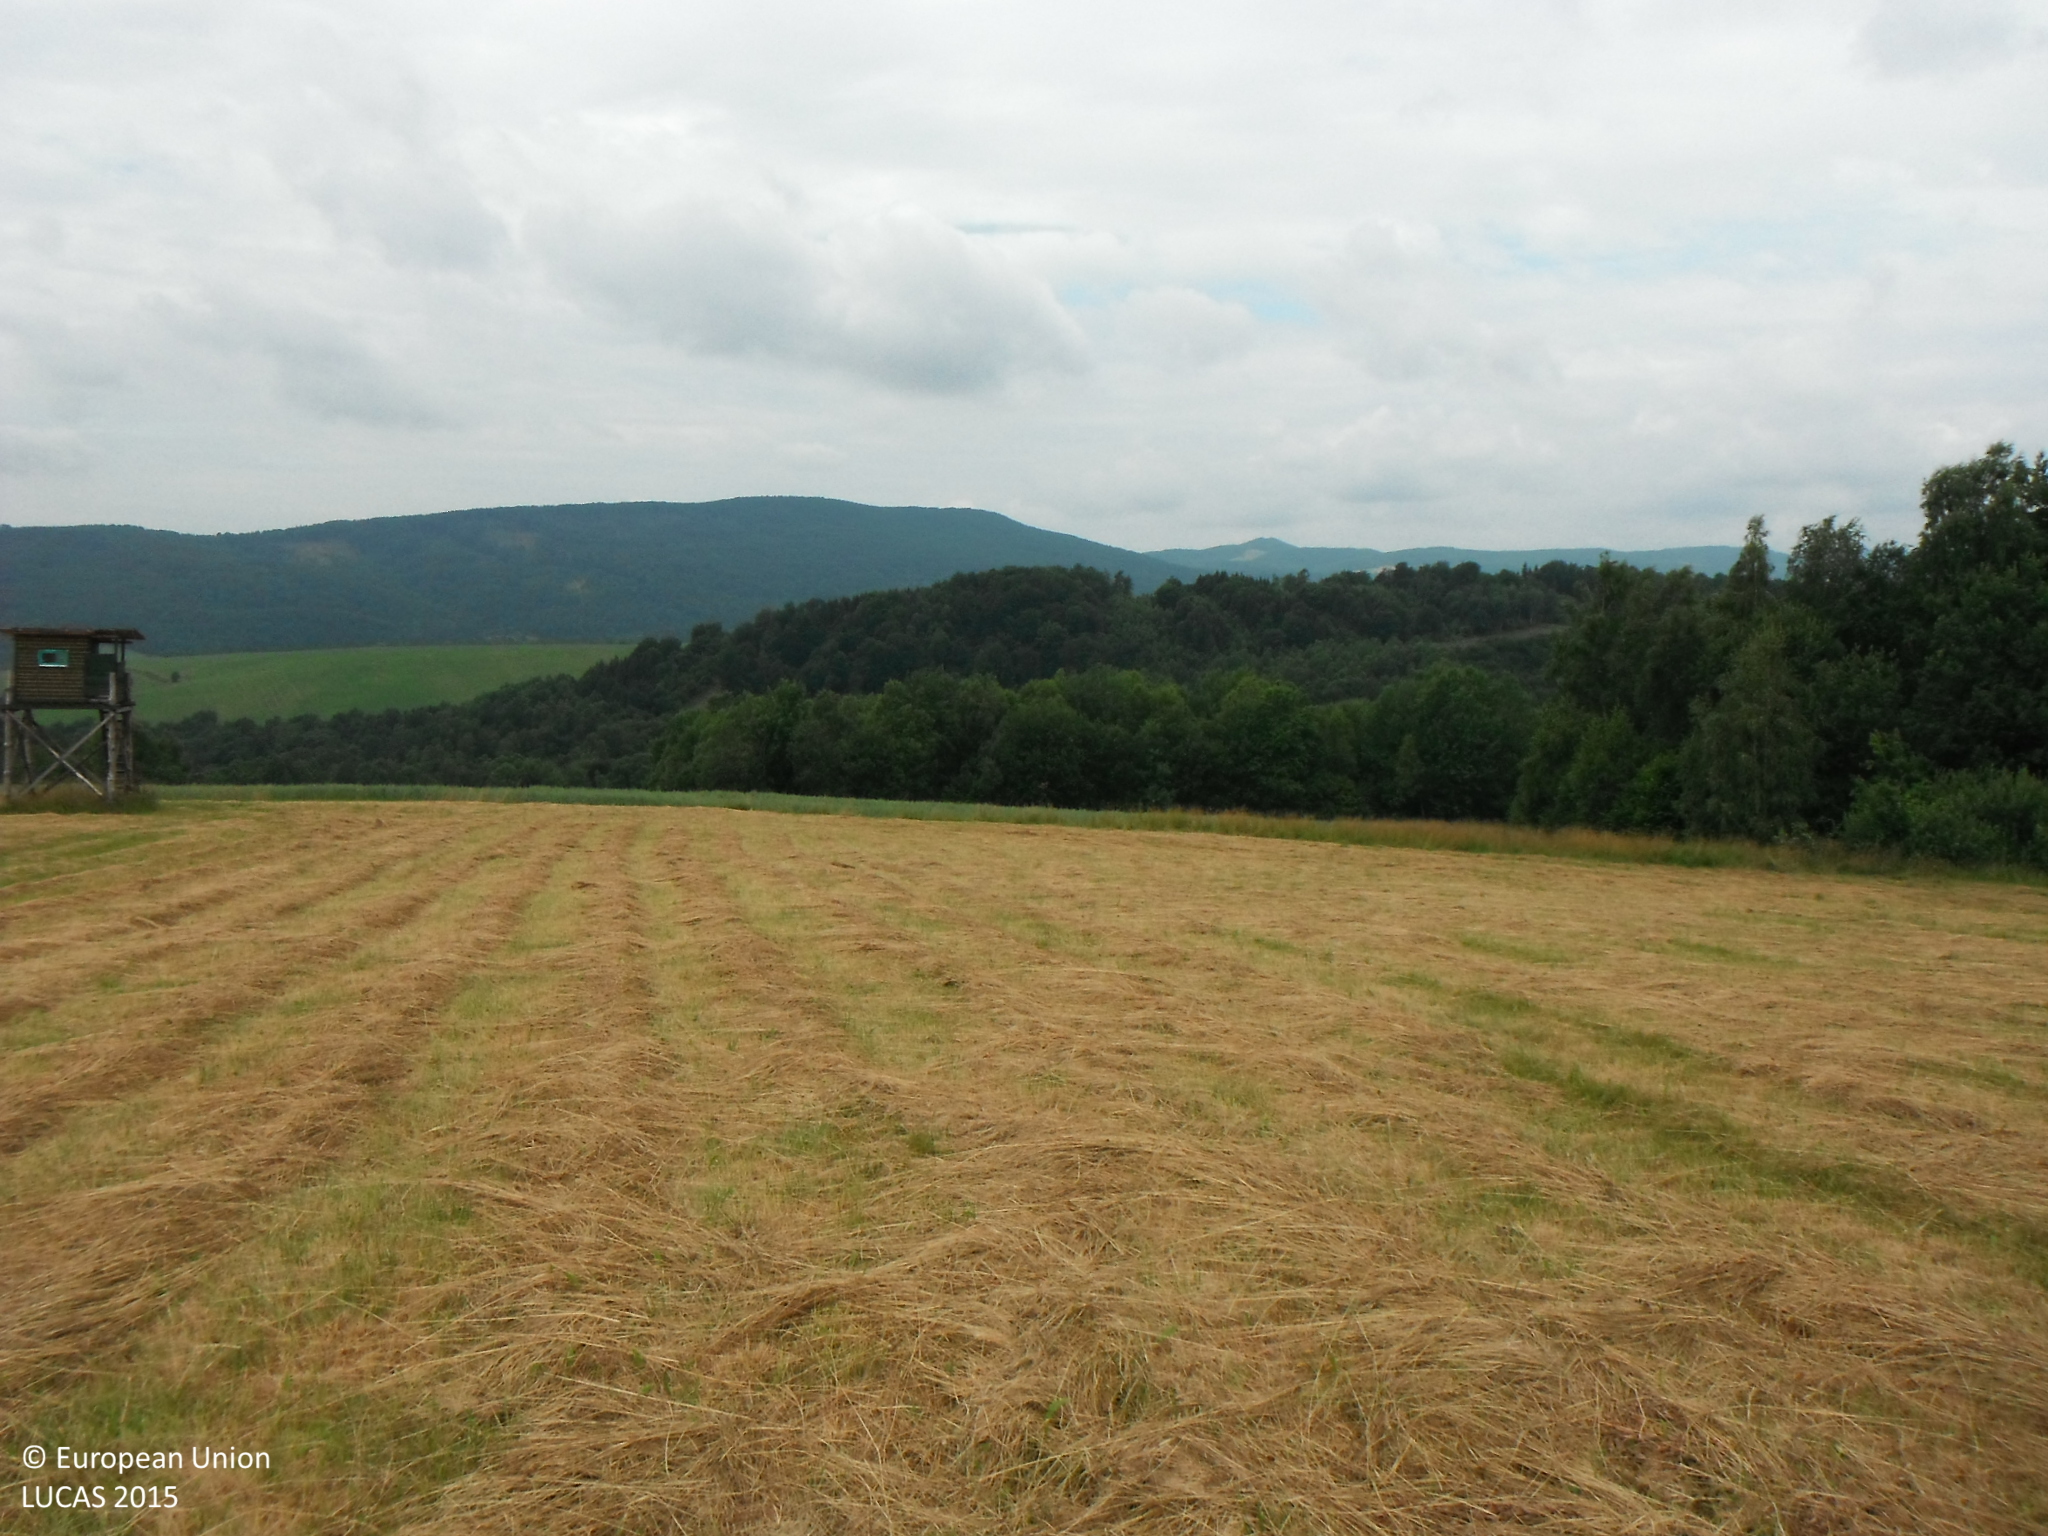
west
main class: Grassland
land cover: Grassland without tree/shrub cover
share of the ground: > 75 %
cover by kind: herbaceous plants 100 %
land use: Agriculture (excluding fallow land and kitchen gardens)
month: July
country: SK
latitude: 49.3014
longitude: 21.9232
